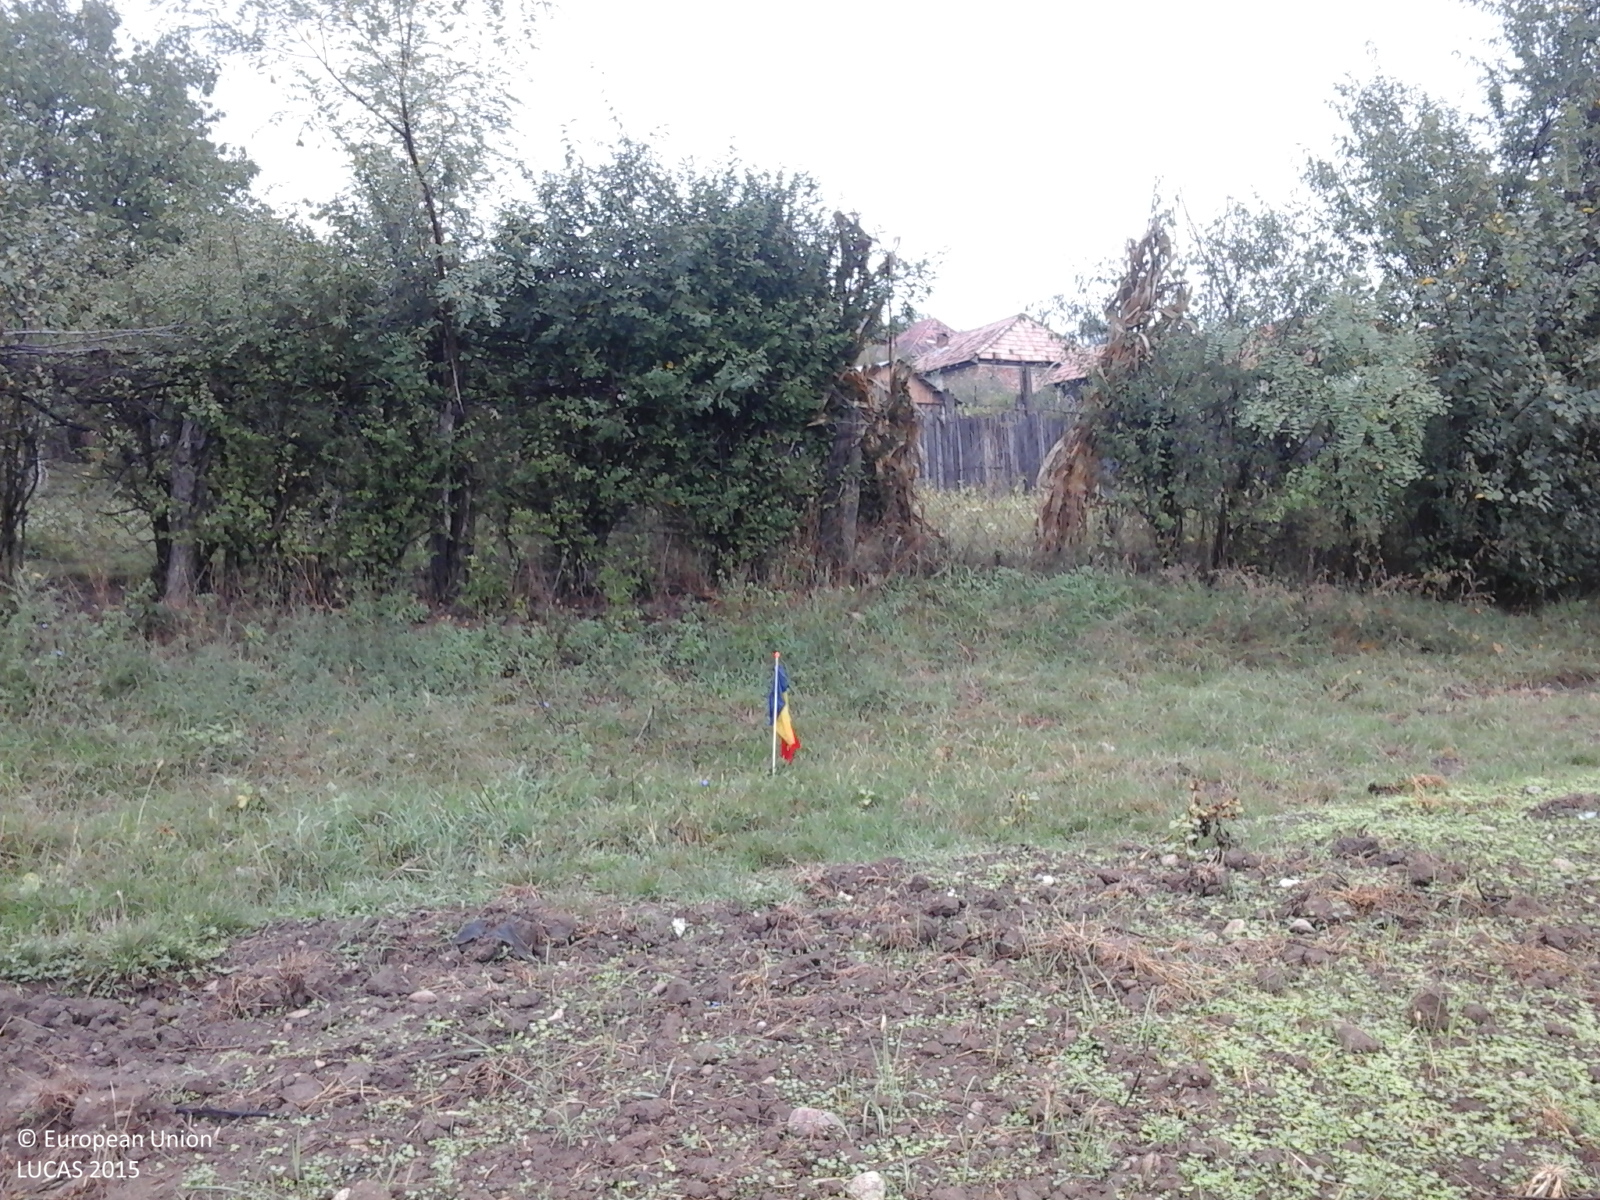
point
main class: Grassland
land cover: Grassland without tree/shrub cover
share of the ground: > 75 %
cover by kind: herbaceous plants 100 %
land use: Agriculture (excluding fallow land and kitchen gardens)
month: September
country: RO
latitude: 45.0488
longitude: 23.5293
